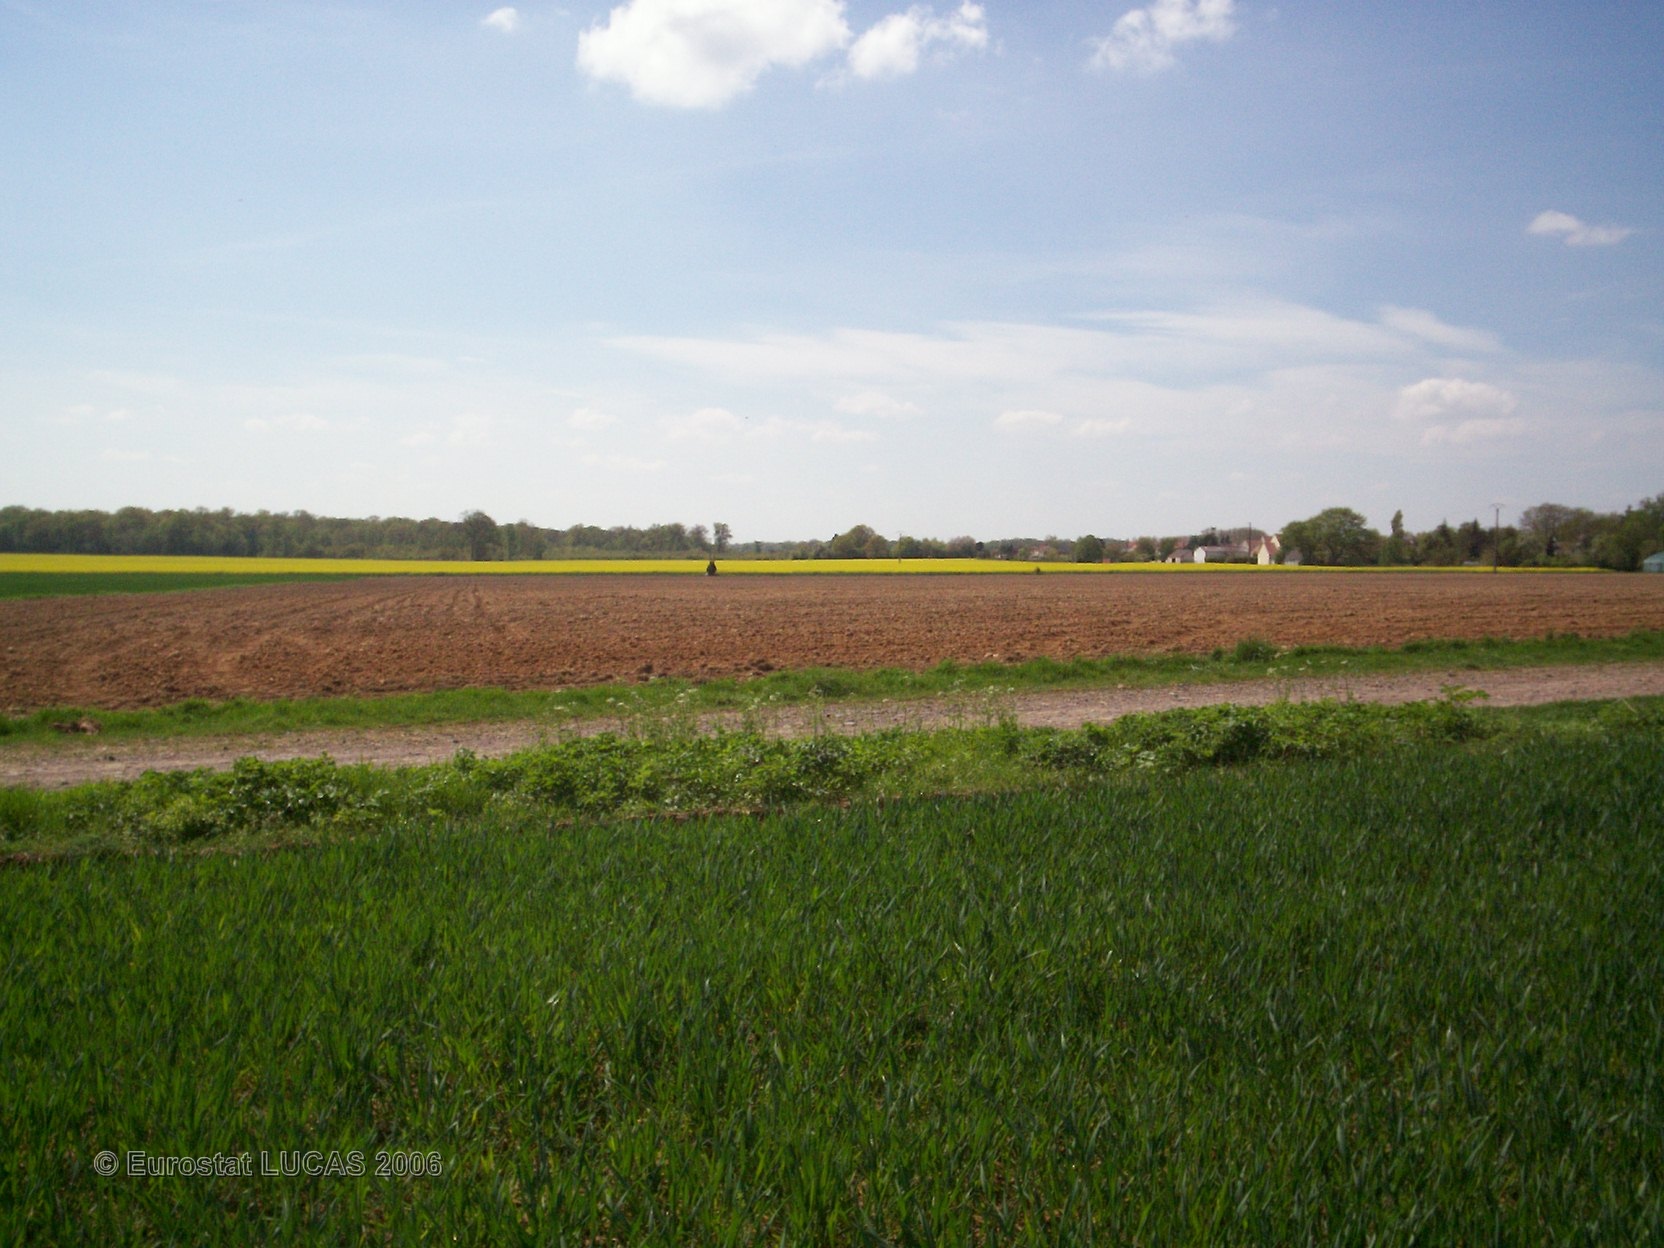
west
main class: Cropland
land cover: Common wheat
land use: Agriculture (excluding fallow land and kitchen gardens)
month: May
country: FR
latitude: 48.8001
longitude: 2.7884
